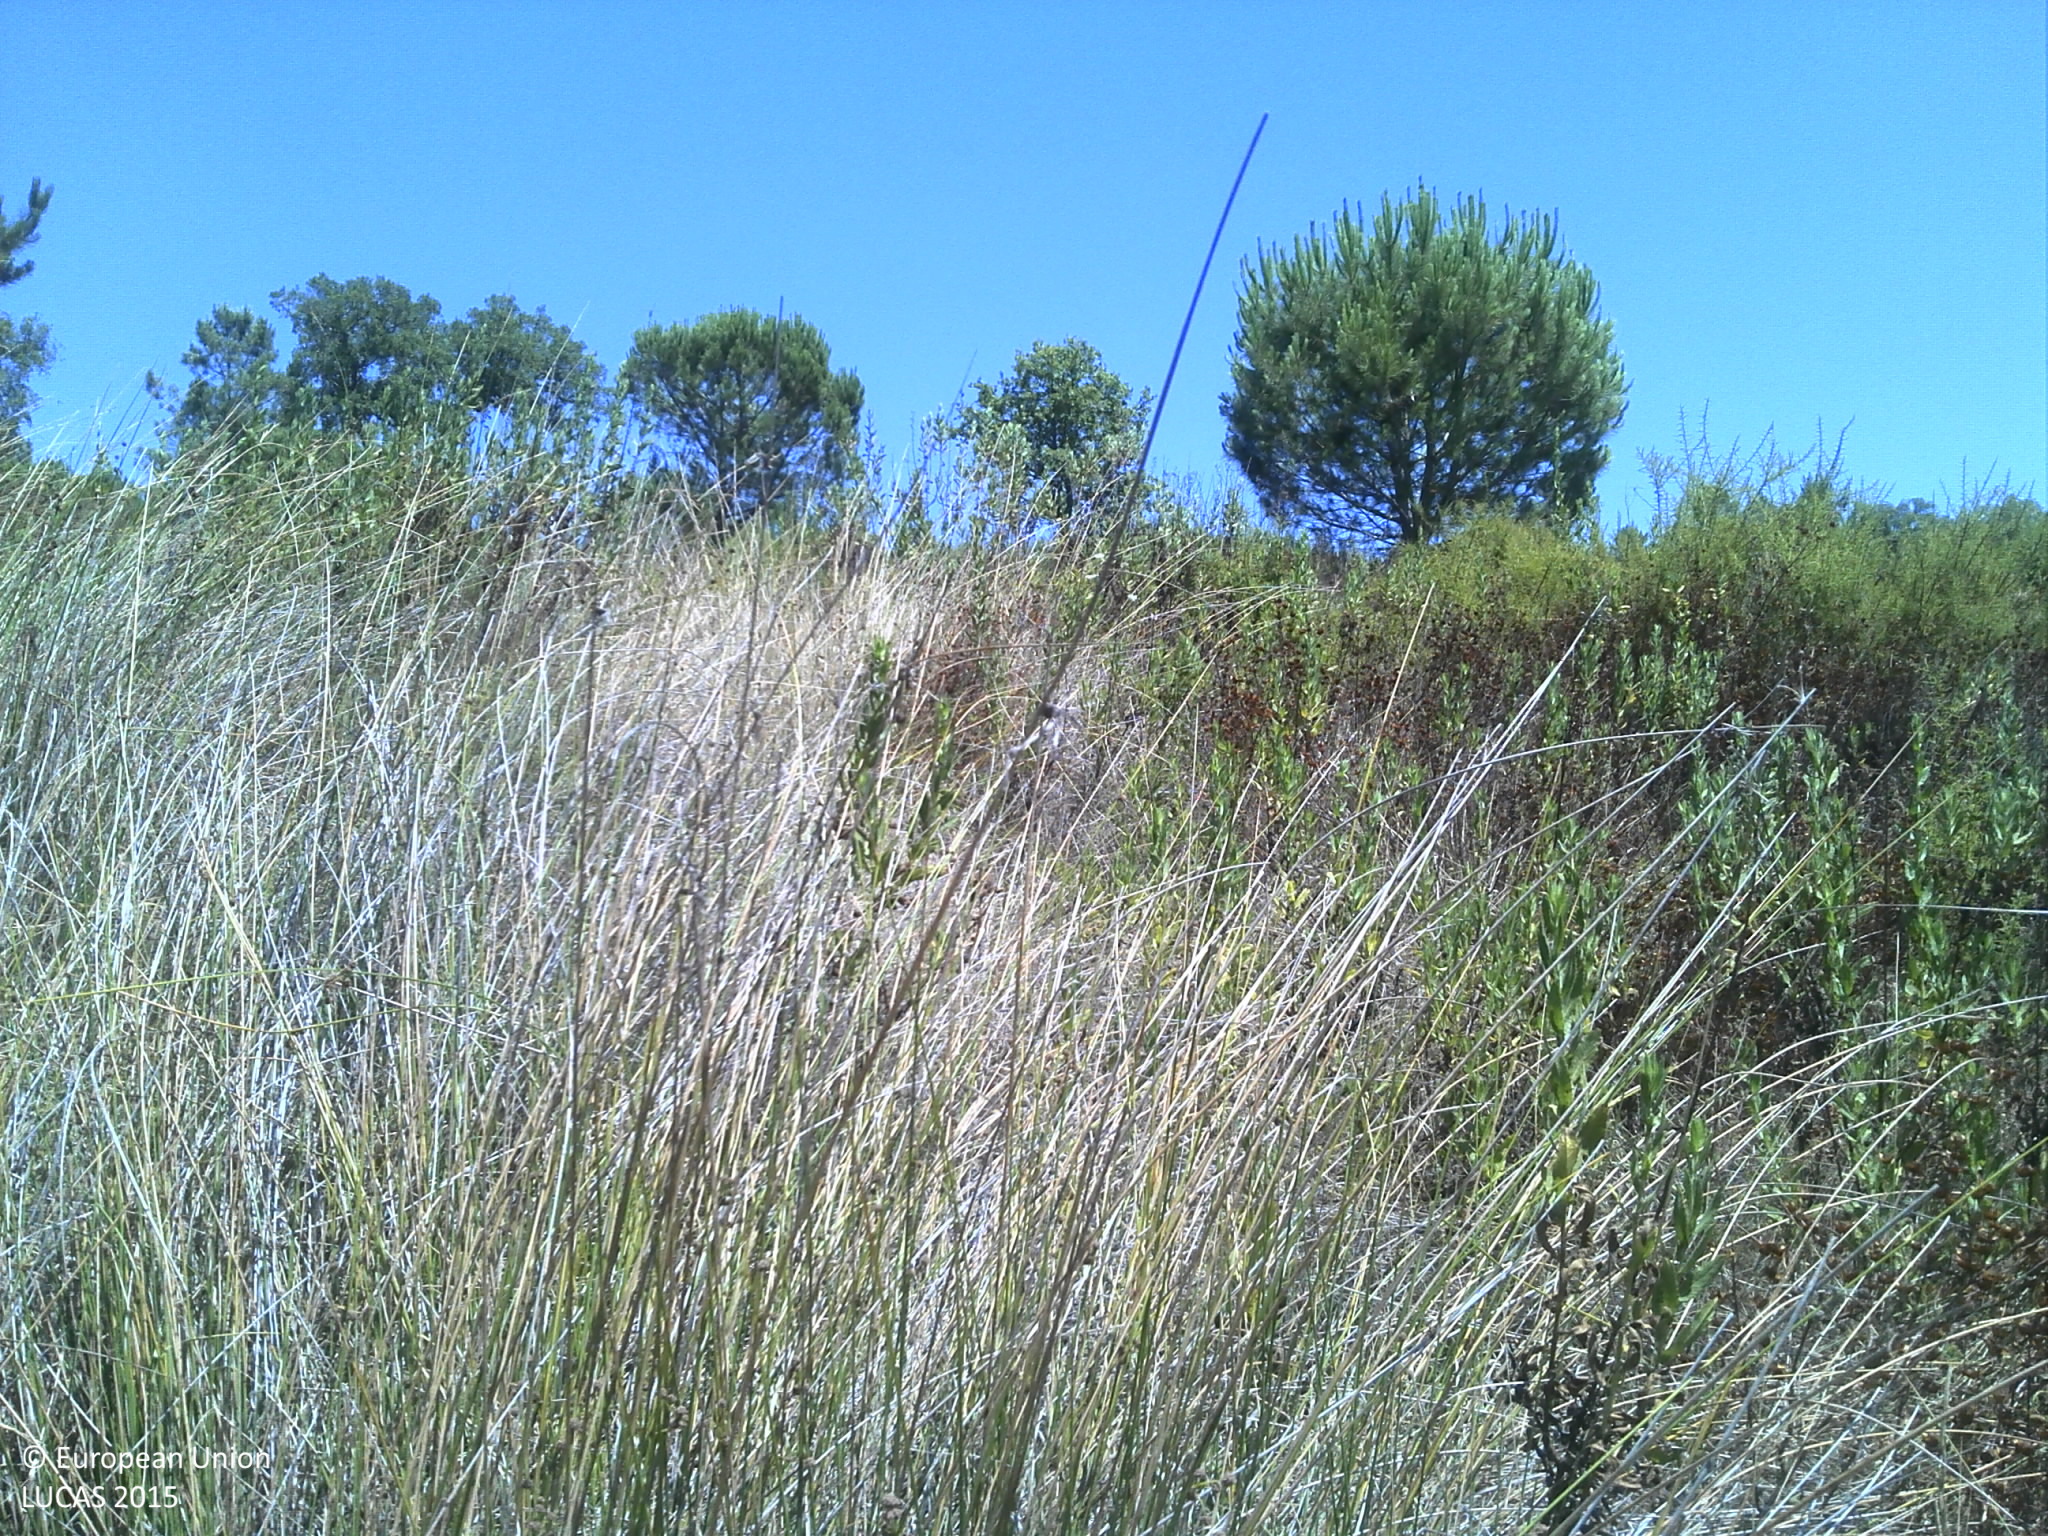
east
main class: Shrubland
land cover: Shrubland without tree cover
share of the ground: 50 - 75 %
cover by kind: shrubs 50 %, unconsolidated bare surface 40 %, herbaceous plants 10 %
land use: Forestry
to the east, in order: Shrubland without tree cover; Broadleaved woodland; Pine dominated coniferous woodland; Shrubland with sparse tree cover; Broadleaved woodland; Grassland with sparse tree/shrub cover; Broadleaved woodland; Pine dominated coniferous woodland
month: July
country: PT
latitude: 39.0247
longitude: -8.2254
